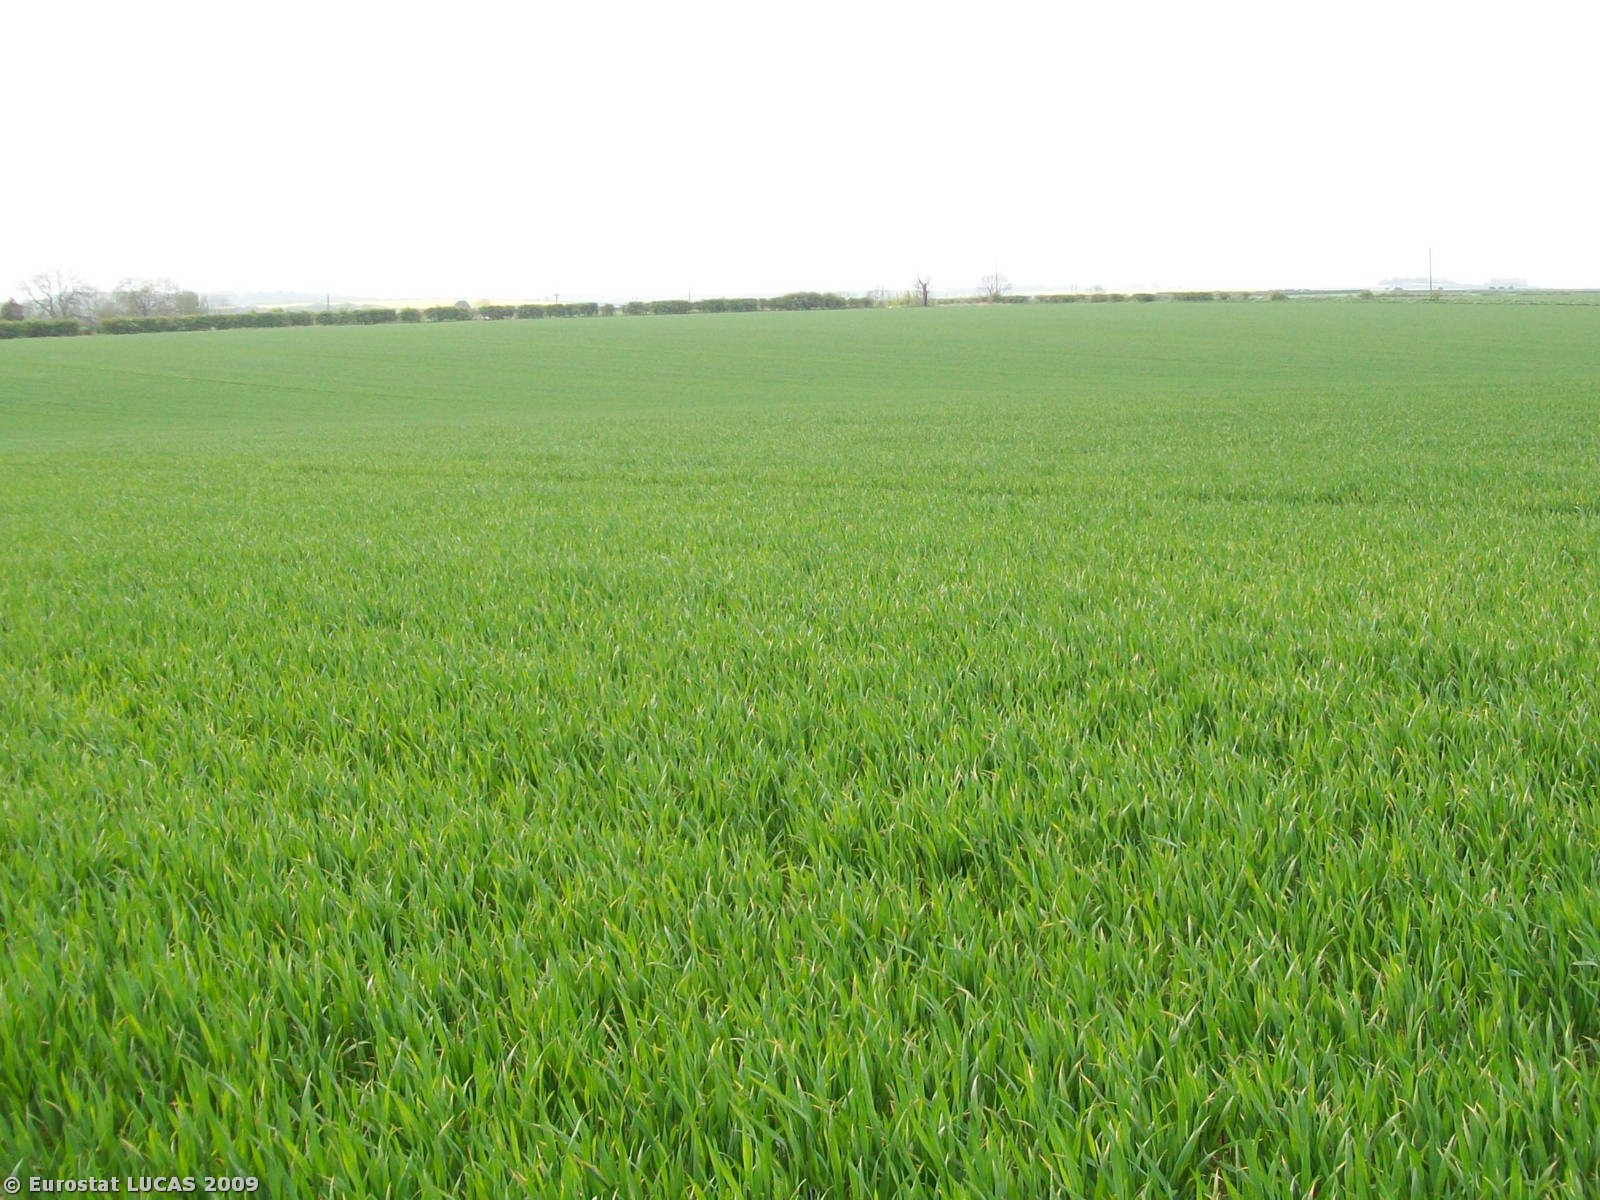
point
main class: Cropland
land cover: Common wheat
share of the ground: > 75 %
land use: Agriculture (excluding fallow land and kitchen gardens)
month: May
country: GB
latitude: 54.1371
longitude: -0.3354
